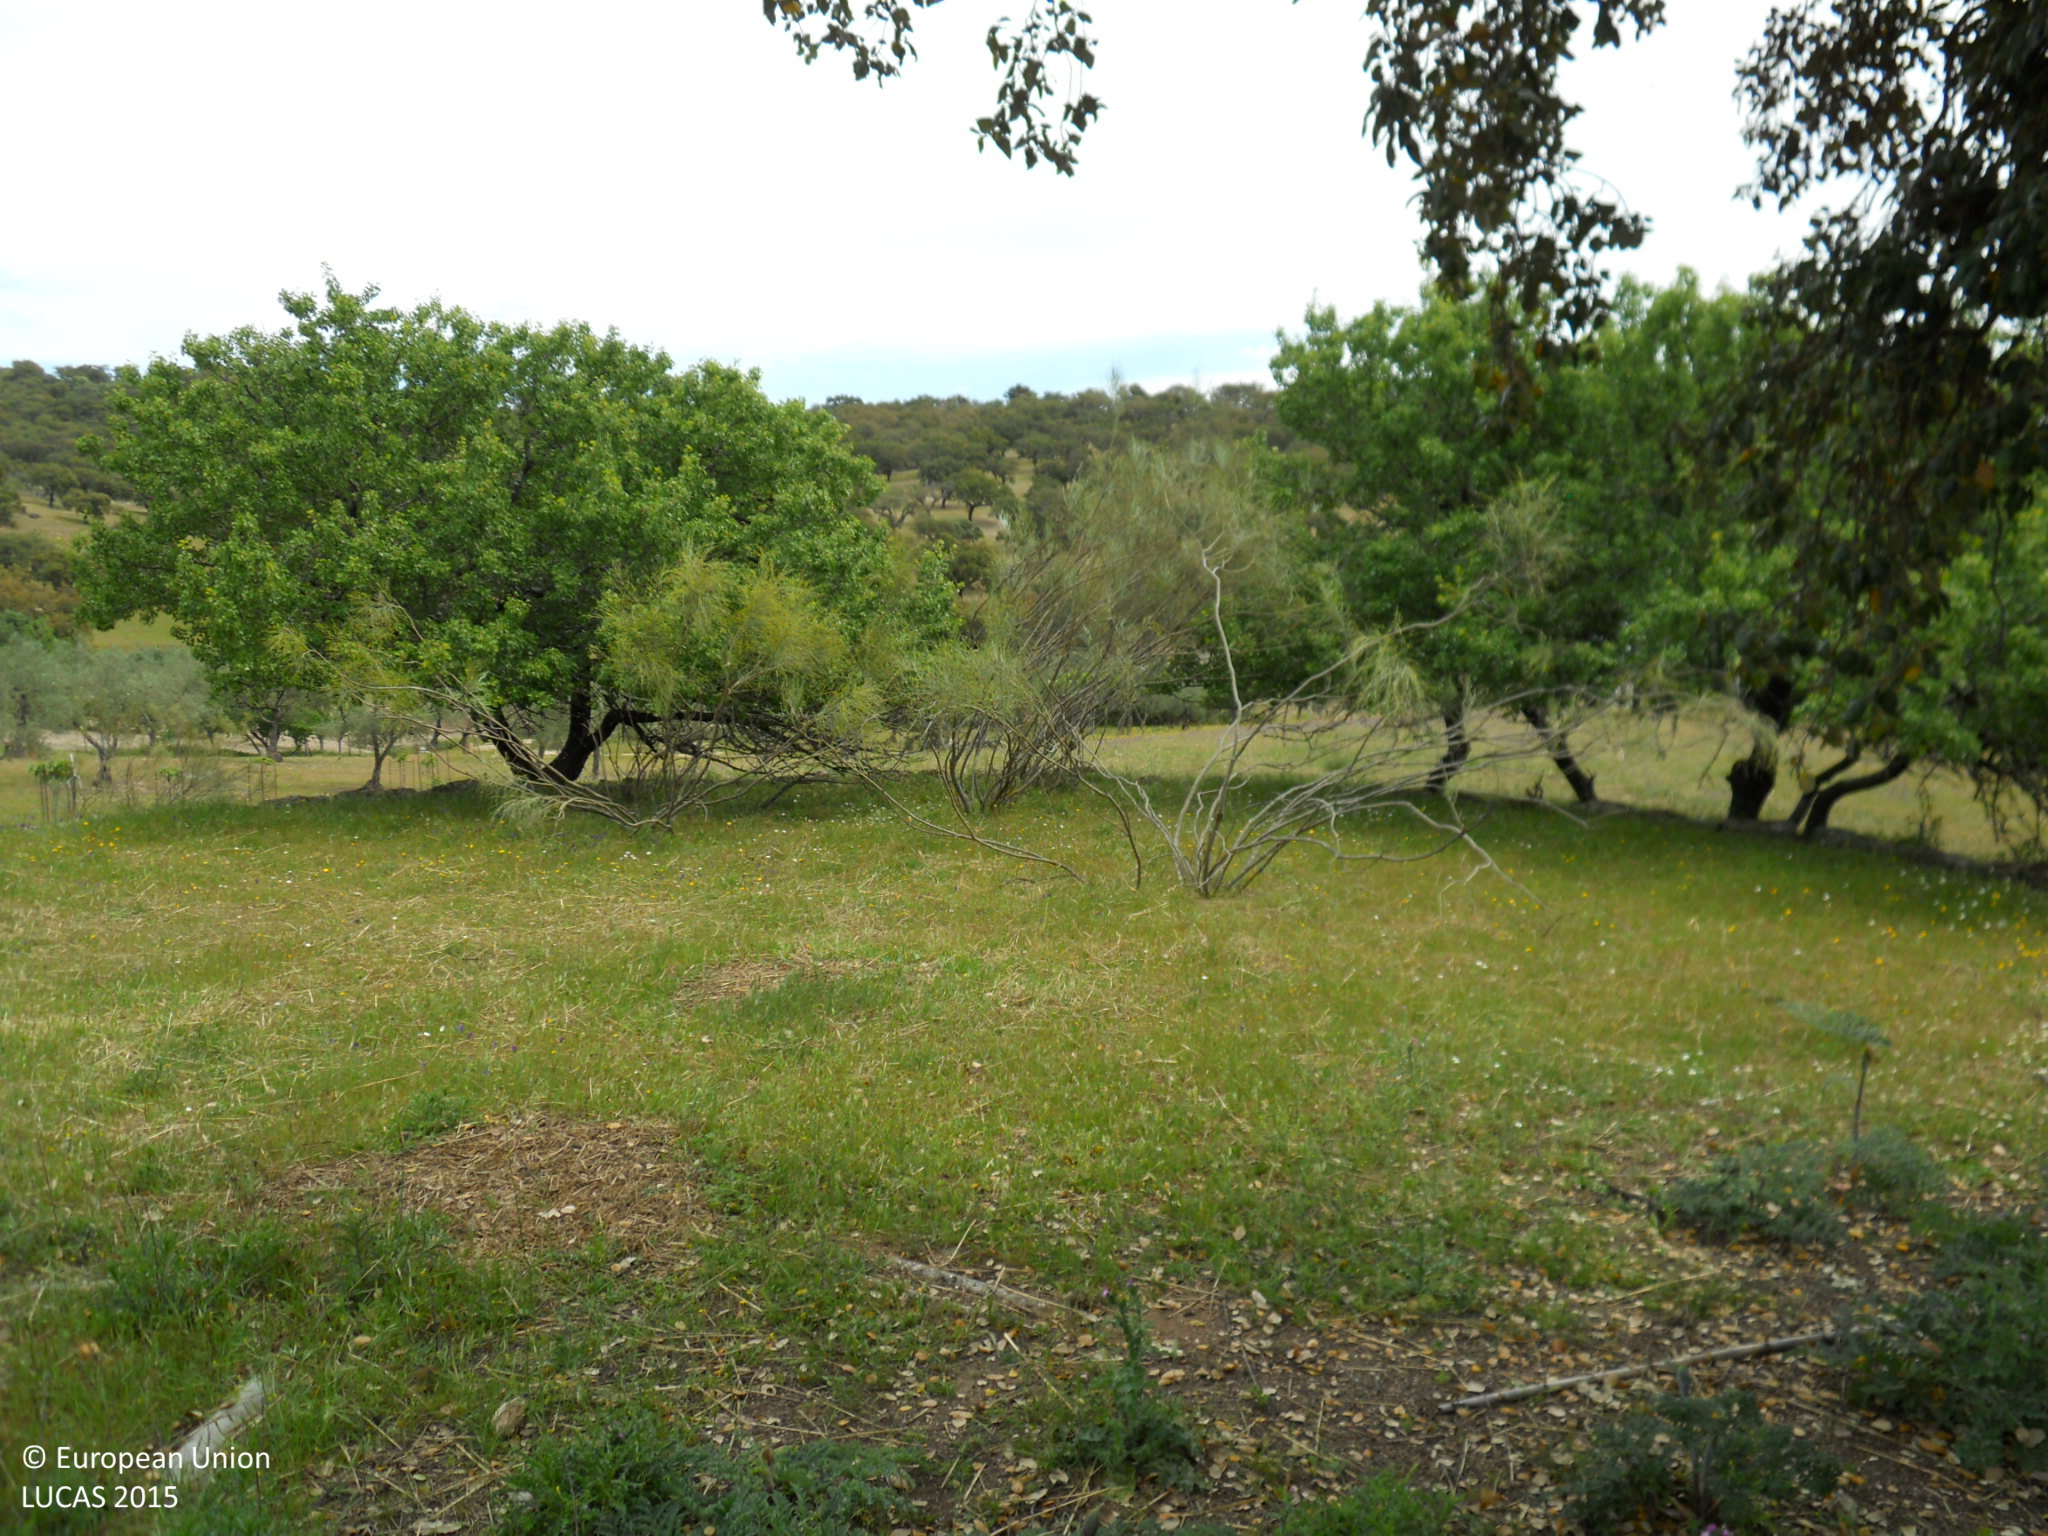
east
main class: Woodland
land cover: Broadleaved woodland
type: broadleaved evergreen forest
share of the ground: 25 - 50 %
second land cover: Grassland without tree/shrub cover
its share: > 75 %
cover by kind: herbaceous plants 80 %, broadleaved forest trees 15 %, shrubs 5 %
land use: Forestry
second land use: Agriculture (excluding fallow land and kitchen gardens)
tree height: > 5 m
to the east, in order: Broadleaved woodland; Grassland without tree/shrub cover; Dry stone walls; Grassland with sparse tree/shrub cover; Olive groves; Fences; Dry stone walls; Broadleaved woodland; Rivers and streams; Broadleaved woodland
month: April
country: ES
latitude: 39.3216
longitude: -7.1207
